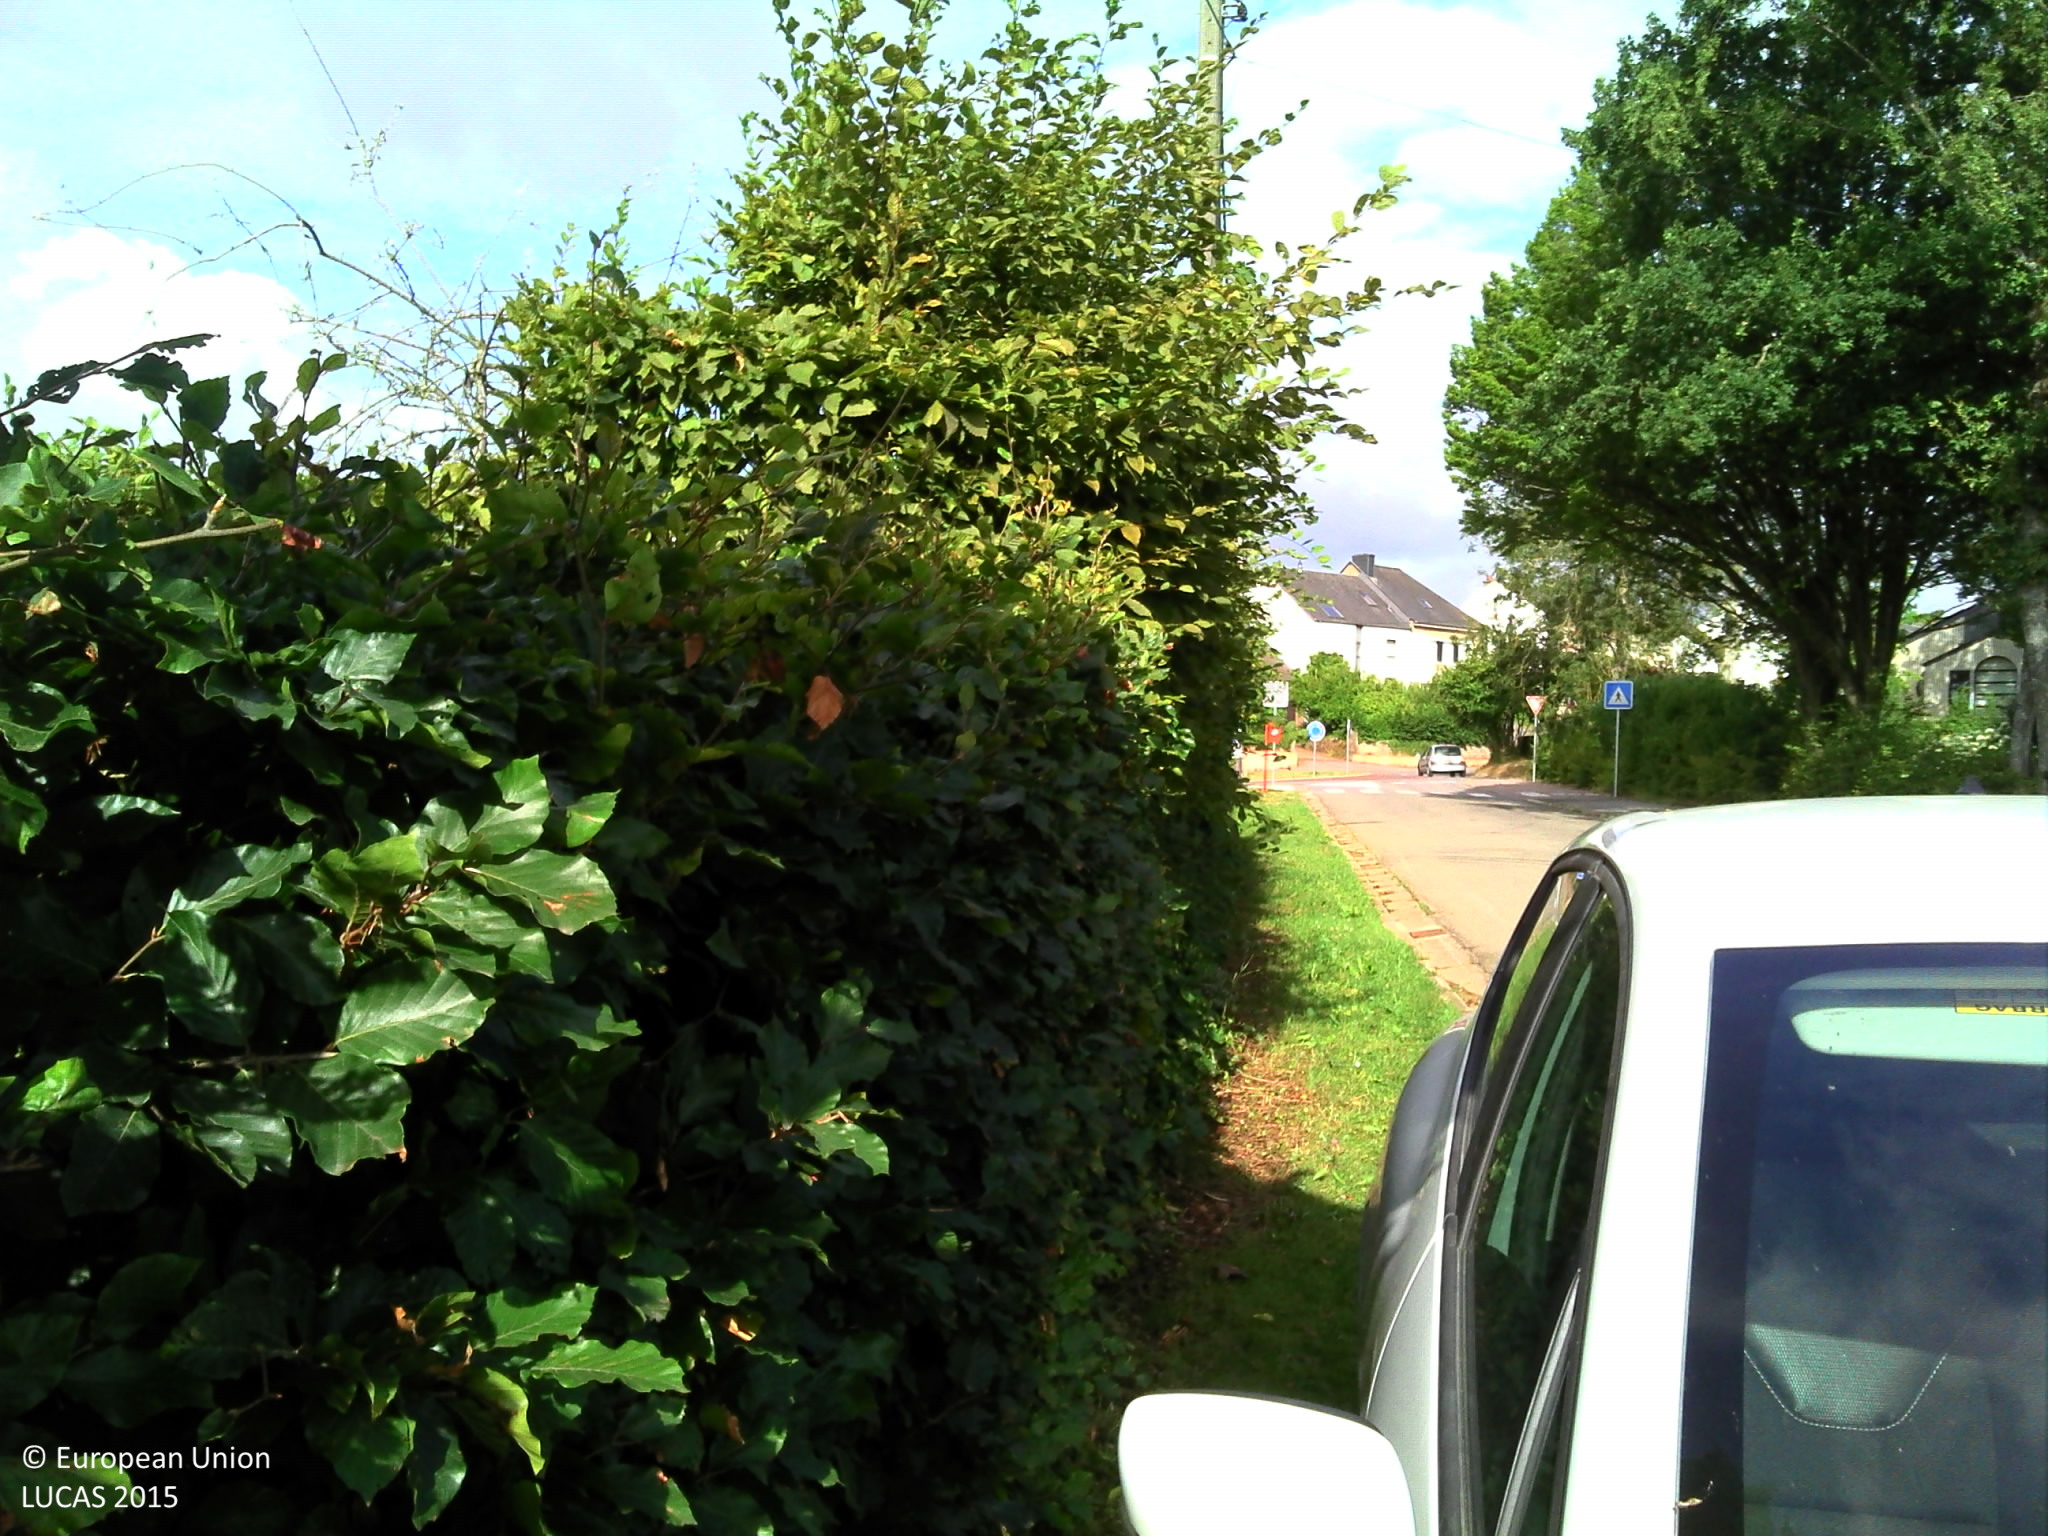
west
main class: Grassland
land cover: Grassland without tree/shrub cover
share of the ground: > 75 %
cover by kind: herbaceous plants 100 %
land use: Residential
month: July
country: BE
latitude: 49.6758
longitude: 5.8278
